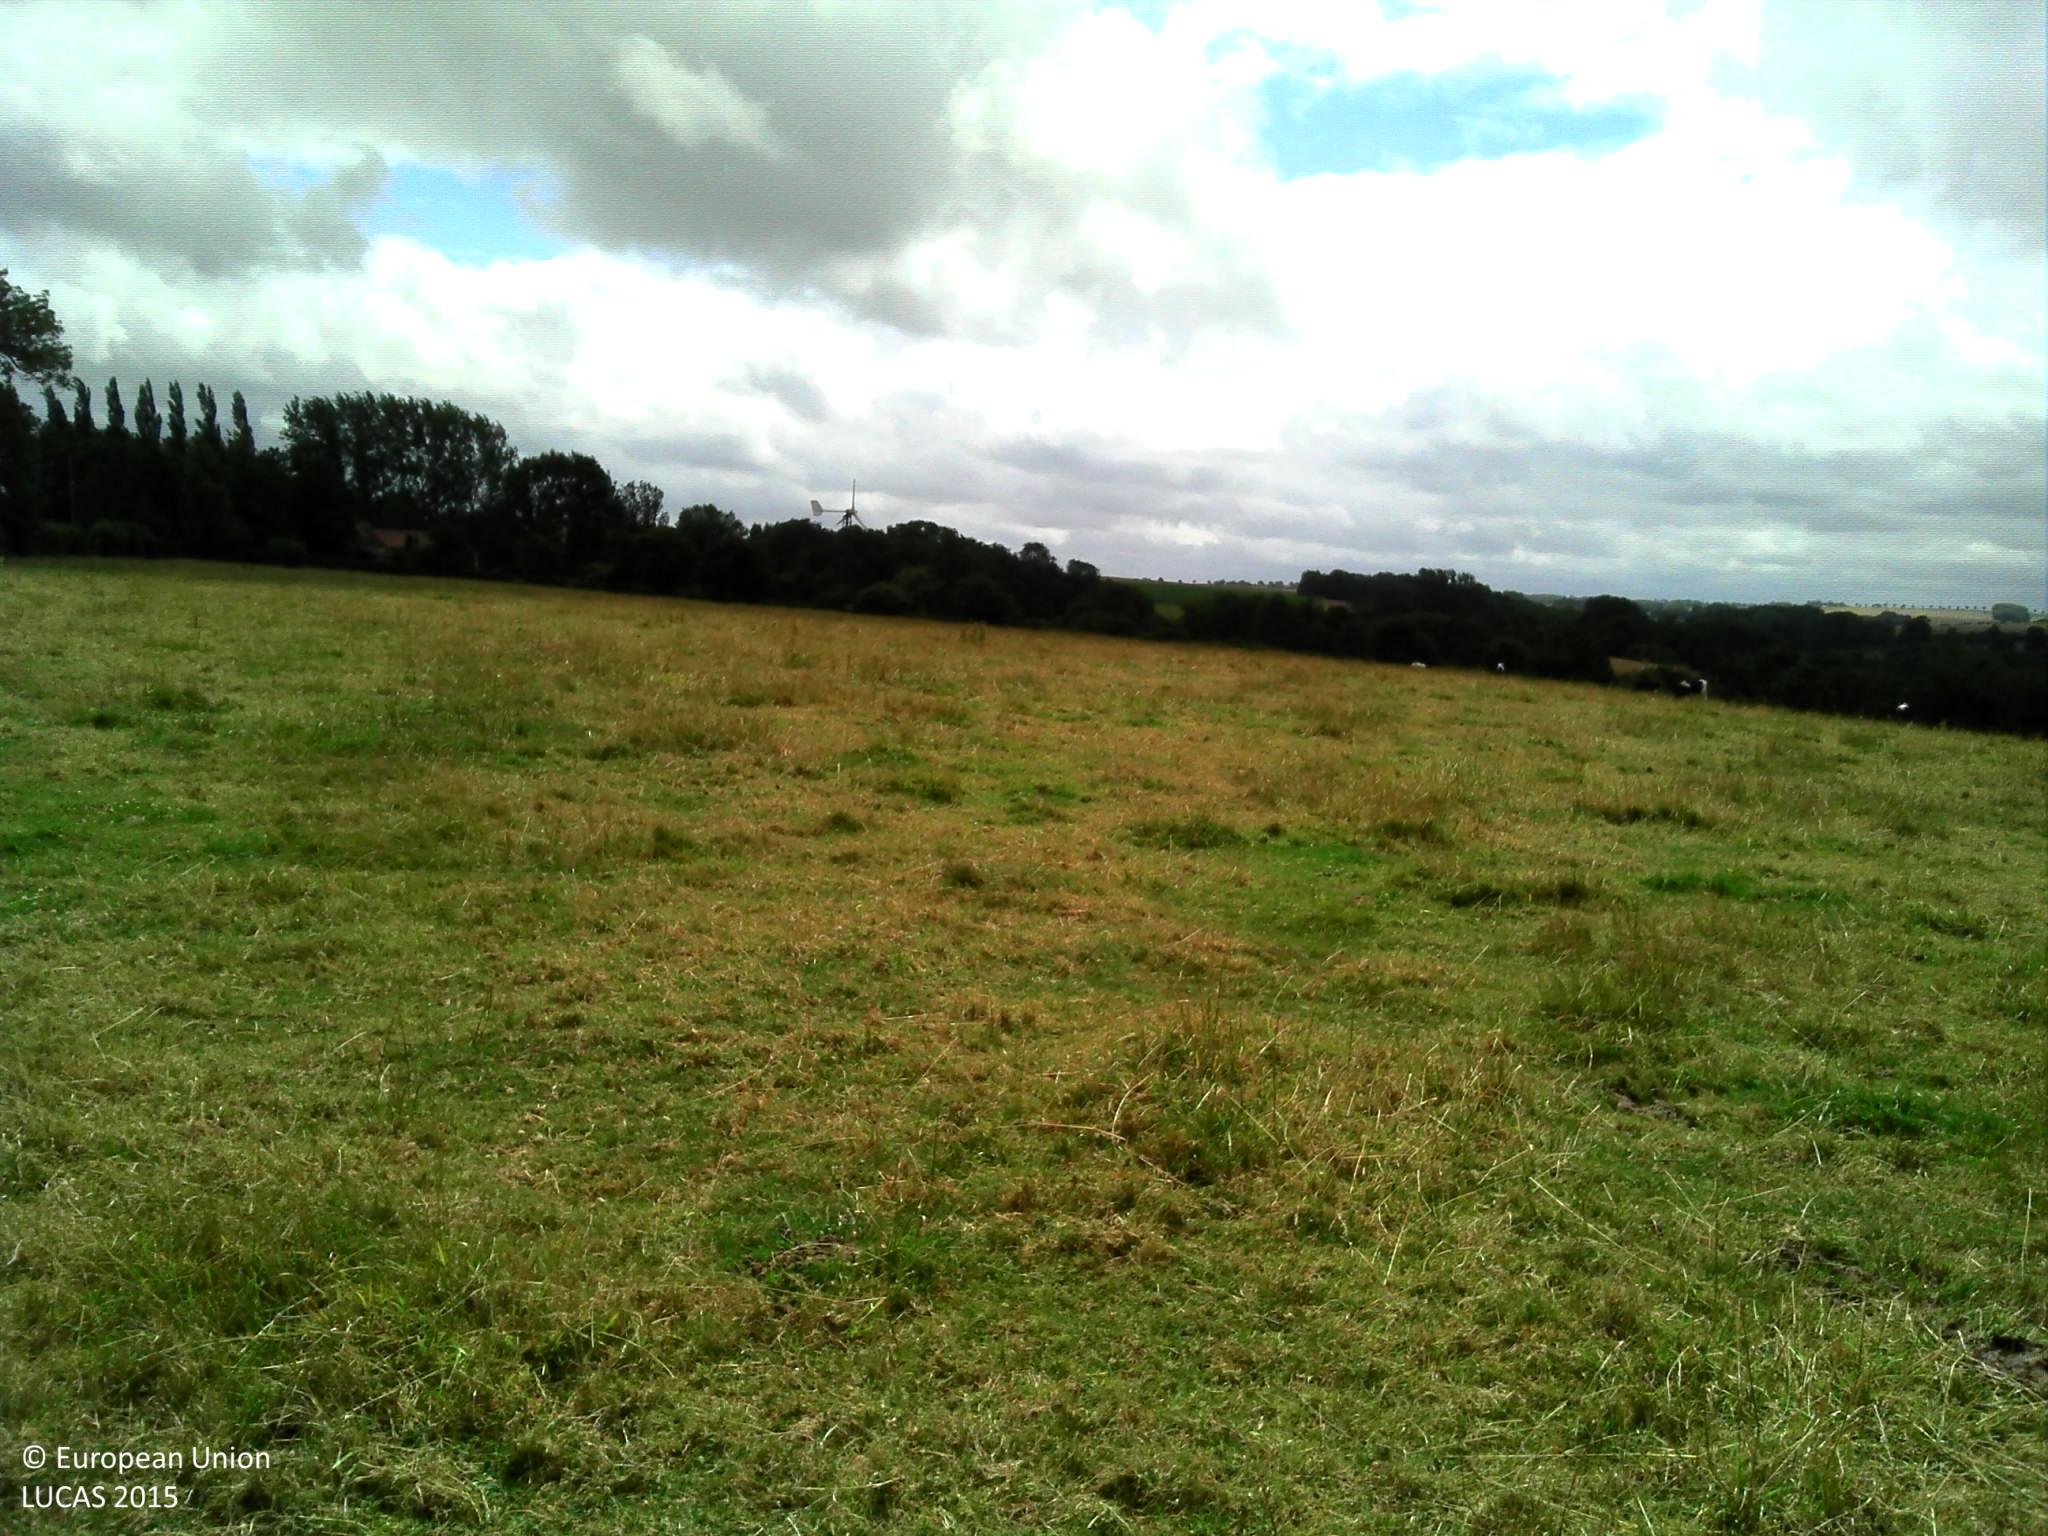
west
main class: Grassland
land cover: Grassland without tree/shrub cover
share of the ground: > 75 %
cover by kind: herbaceous plants 100 %
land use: Agriculture (excluding fallow land and kitchen gardens)
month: July
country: FR
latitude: 50.6709
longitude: 2.1320
